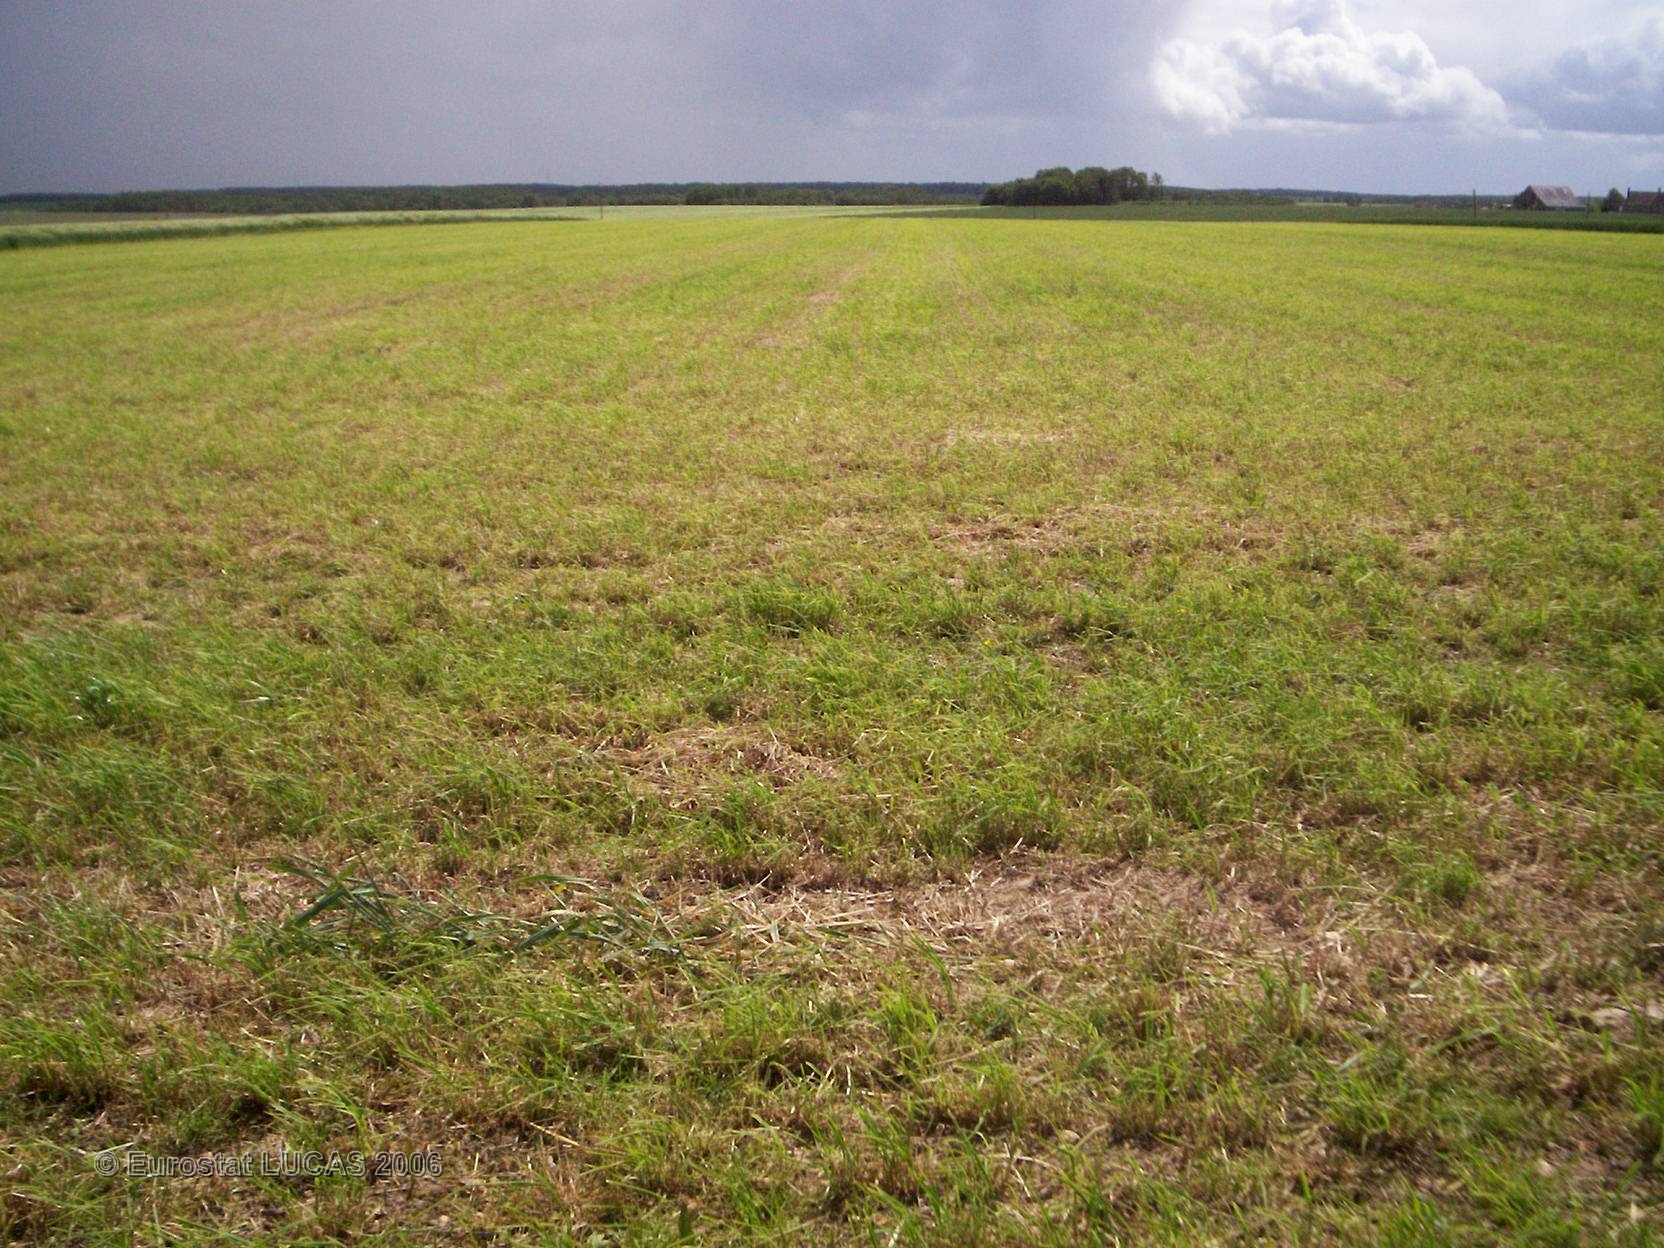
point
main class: Grassland
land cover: Grassland without tree/shrub cover
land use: Agriculture (excluding fallow land and kitchen gardens)
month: May
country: FR
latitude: 47.6241
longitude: 0.8393
